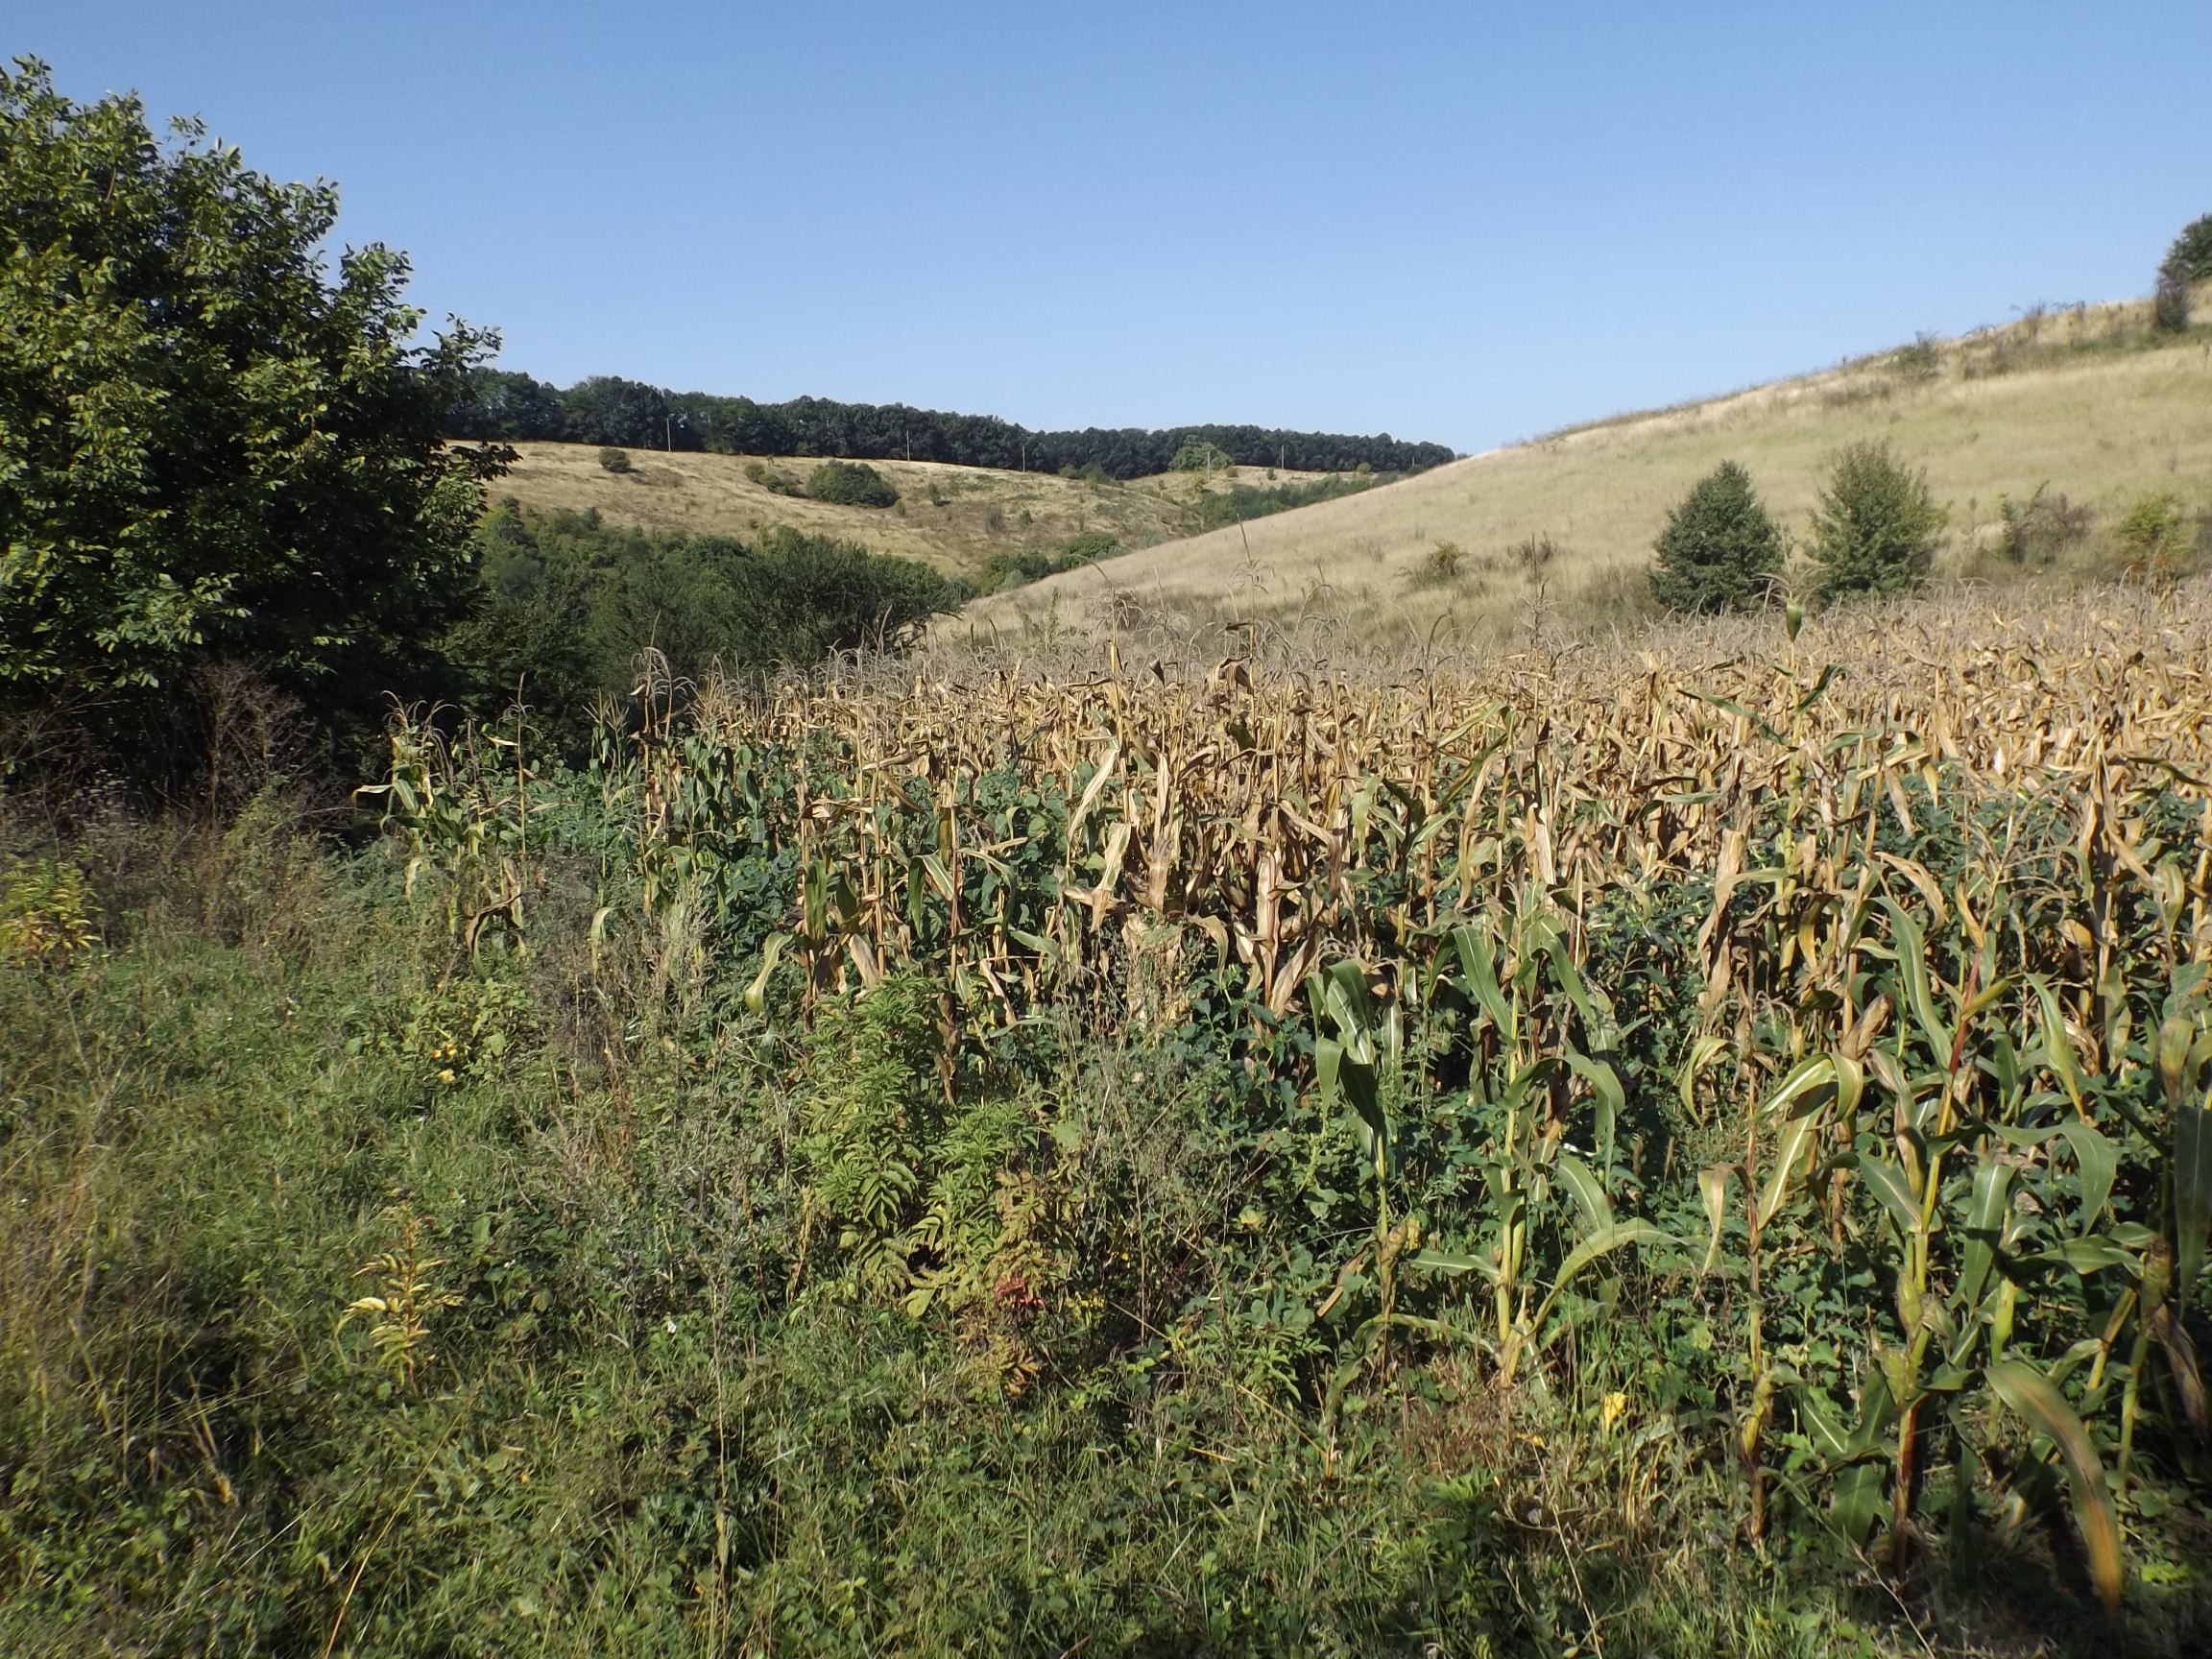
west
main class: Grassland
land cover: Grassland with sparse tree/shrub cover
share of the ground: > 75 %
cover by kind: herbaceous plants 85 %, shrubs 10 %, broadleaved forest trees 5 %
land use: Semi-natural and natural areas not in use
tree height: < 5 m
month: September
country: BG
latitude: 44.0609
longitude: 26.7583
